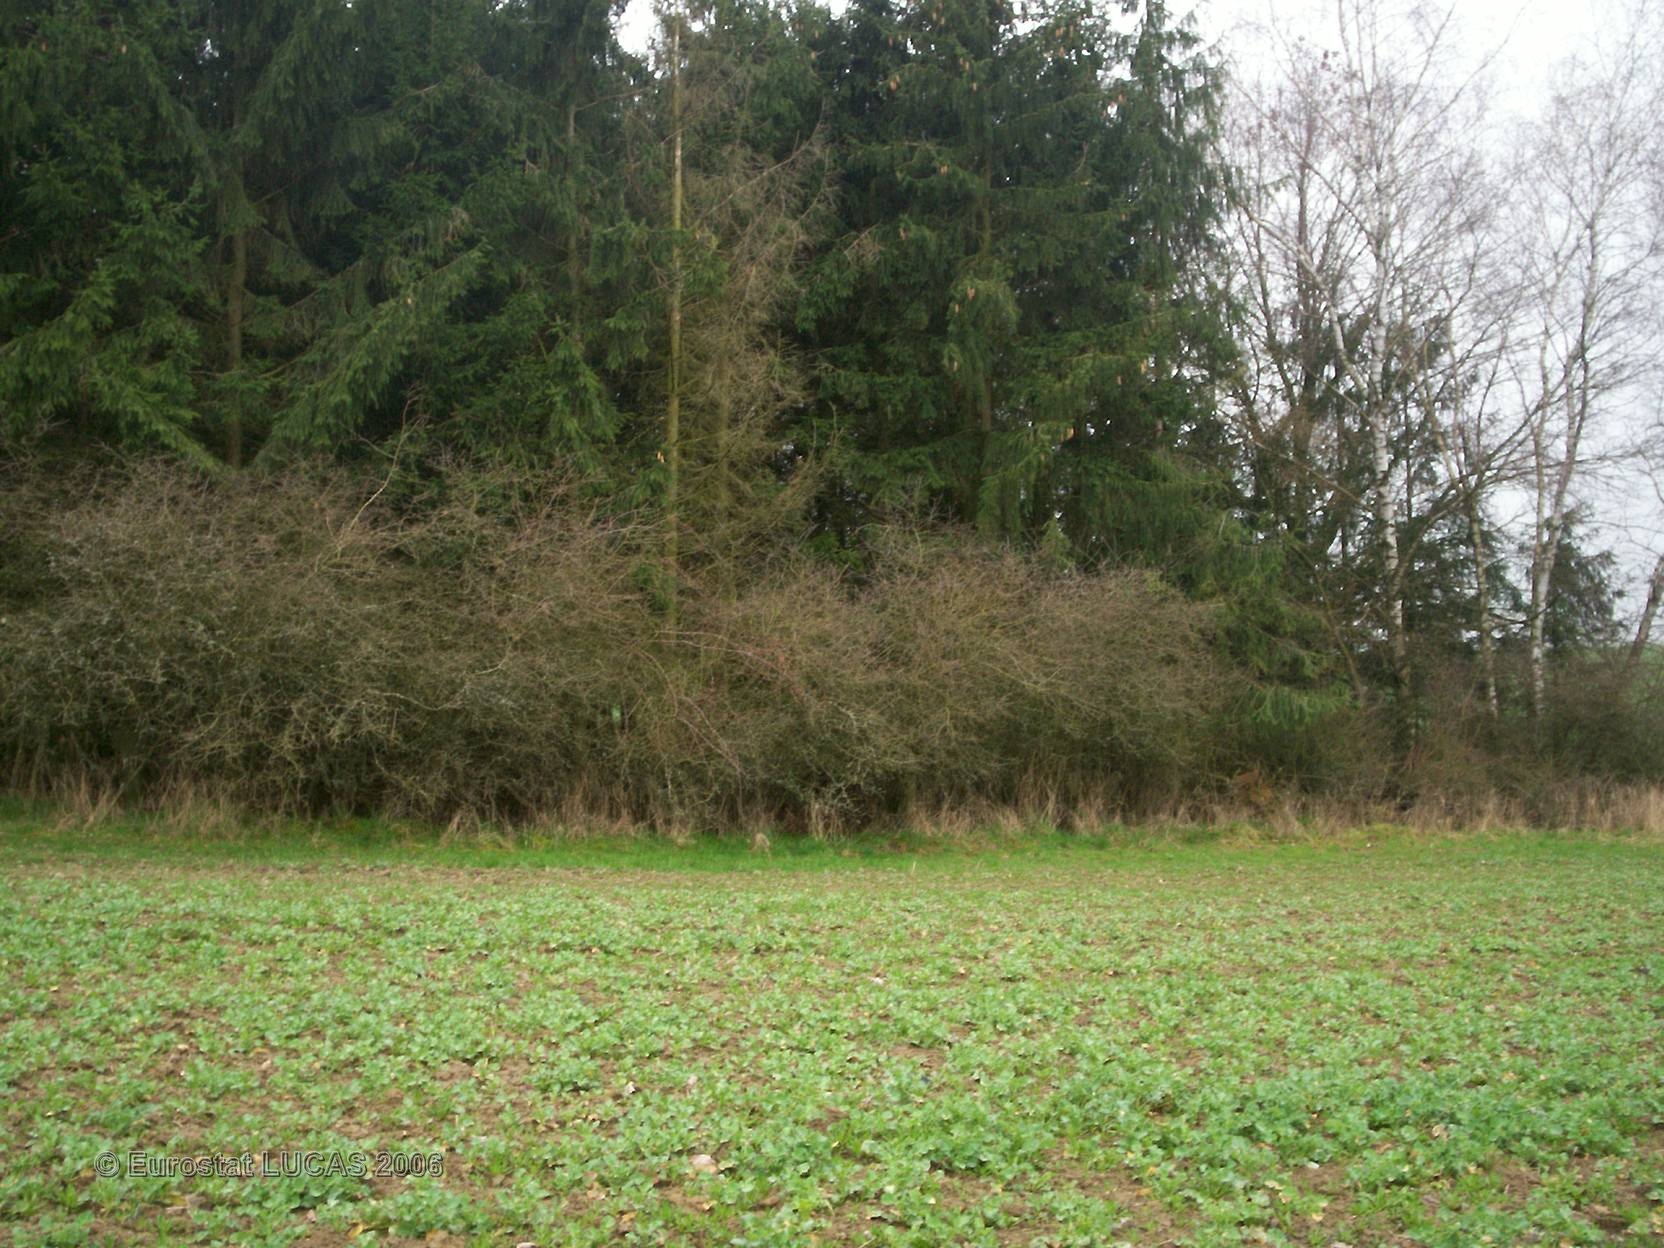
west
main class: Cropland
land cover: Rape and turnip rape
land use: Agriculture (excluding fallow land and kitchen gardens)
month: April
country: FR
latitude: 48.6628
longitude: 6.7827
